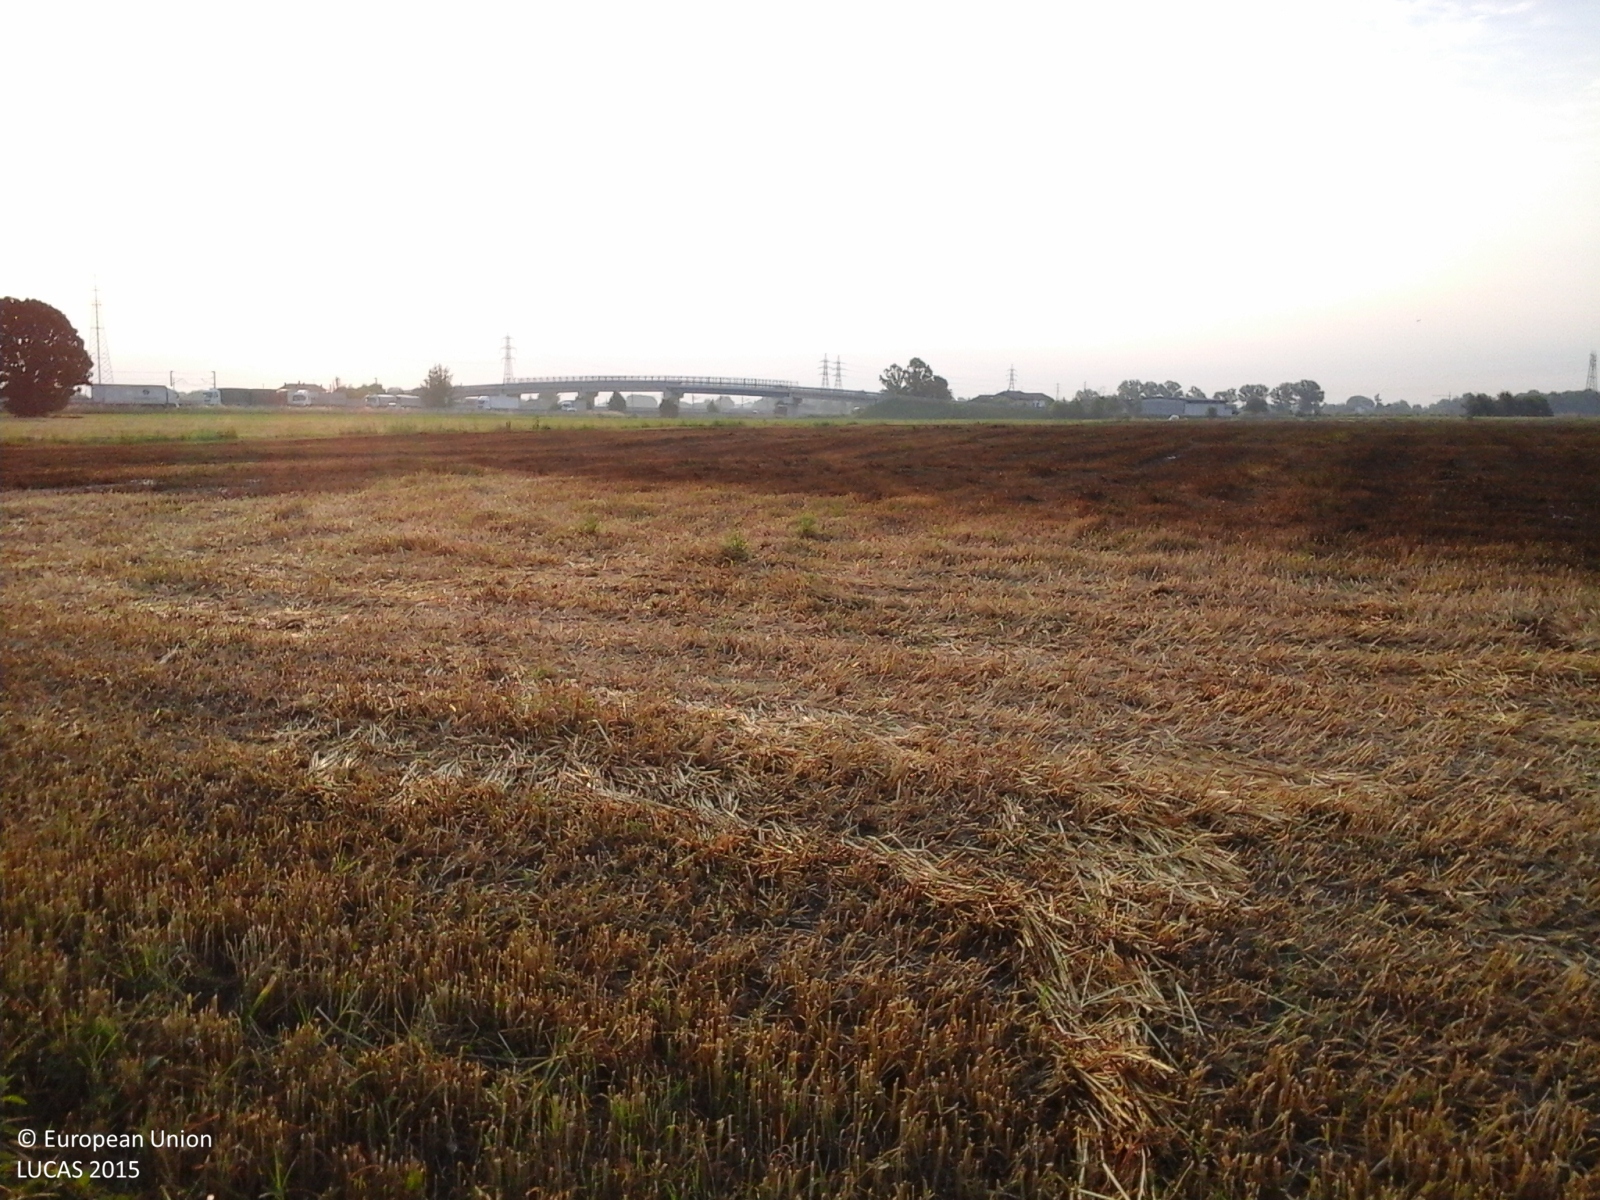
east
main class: Grassland
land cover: Spontaneously vegetated surfaces
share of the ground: 10 - 25 %
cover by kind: unconsolidated bare surface 90 %, herbaceous plants 10 %
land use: Agriculture (excluding fallow land and kitchen gardens)
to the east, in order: Ditches and canals; Temporary grasslands; Grass margins; Ditches and canals; Grass margins; Tracks; Spontaneously vegetated surfaces
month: June
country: IT
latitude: 44.8915
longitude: 10.0632
